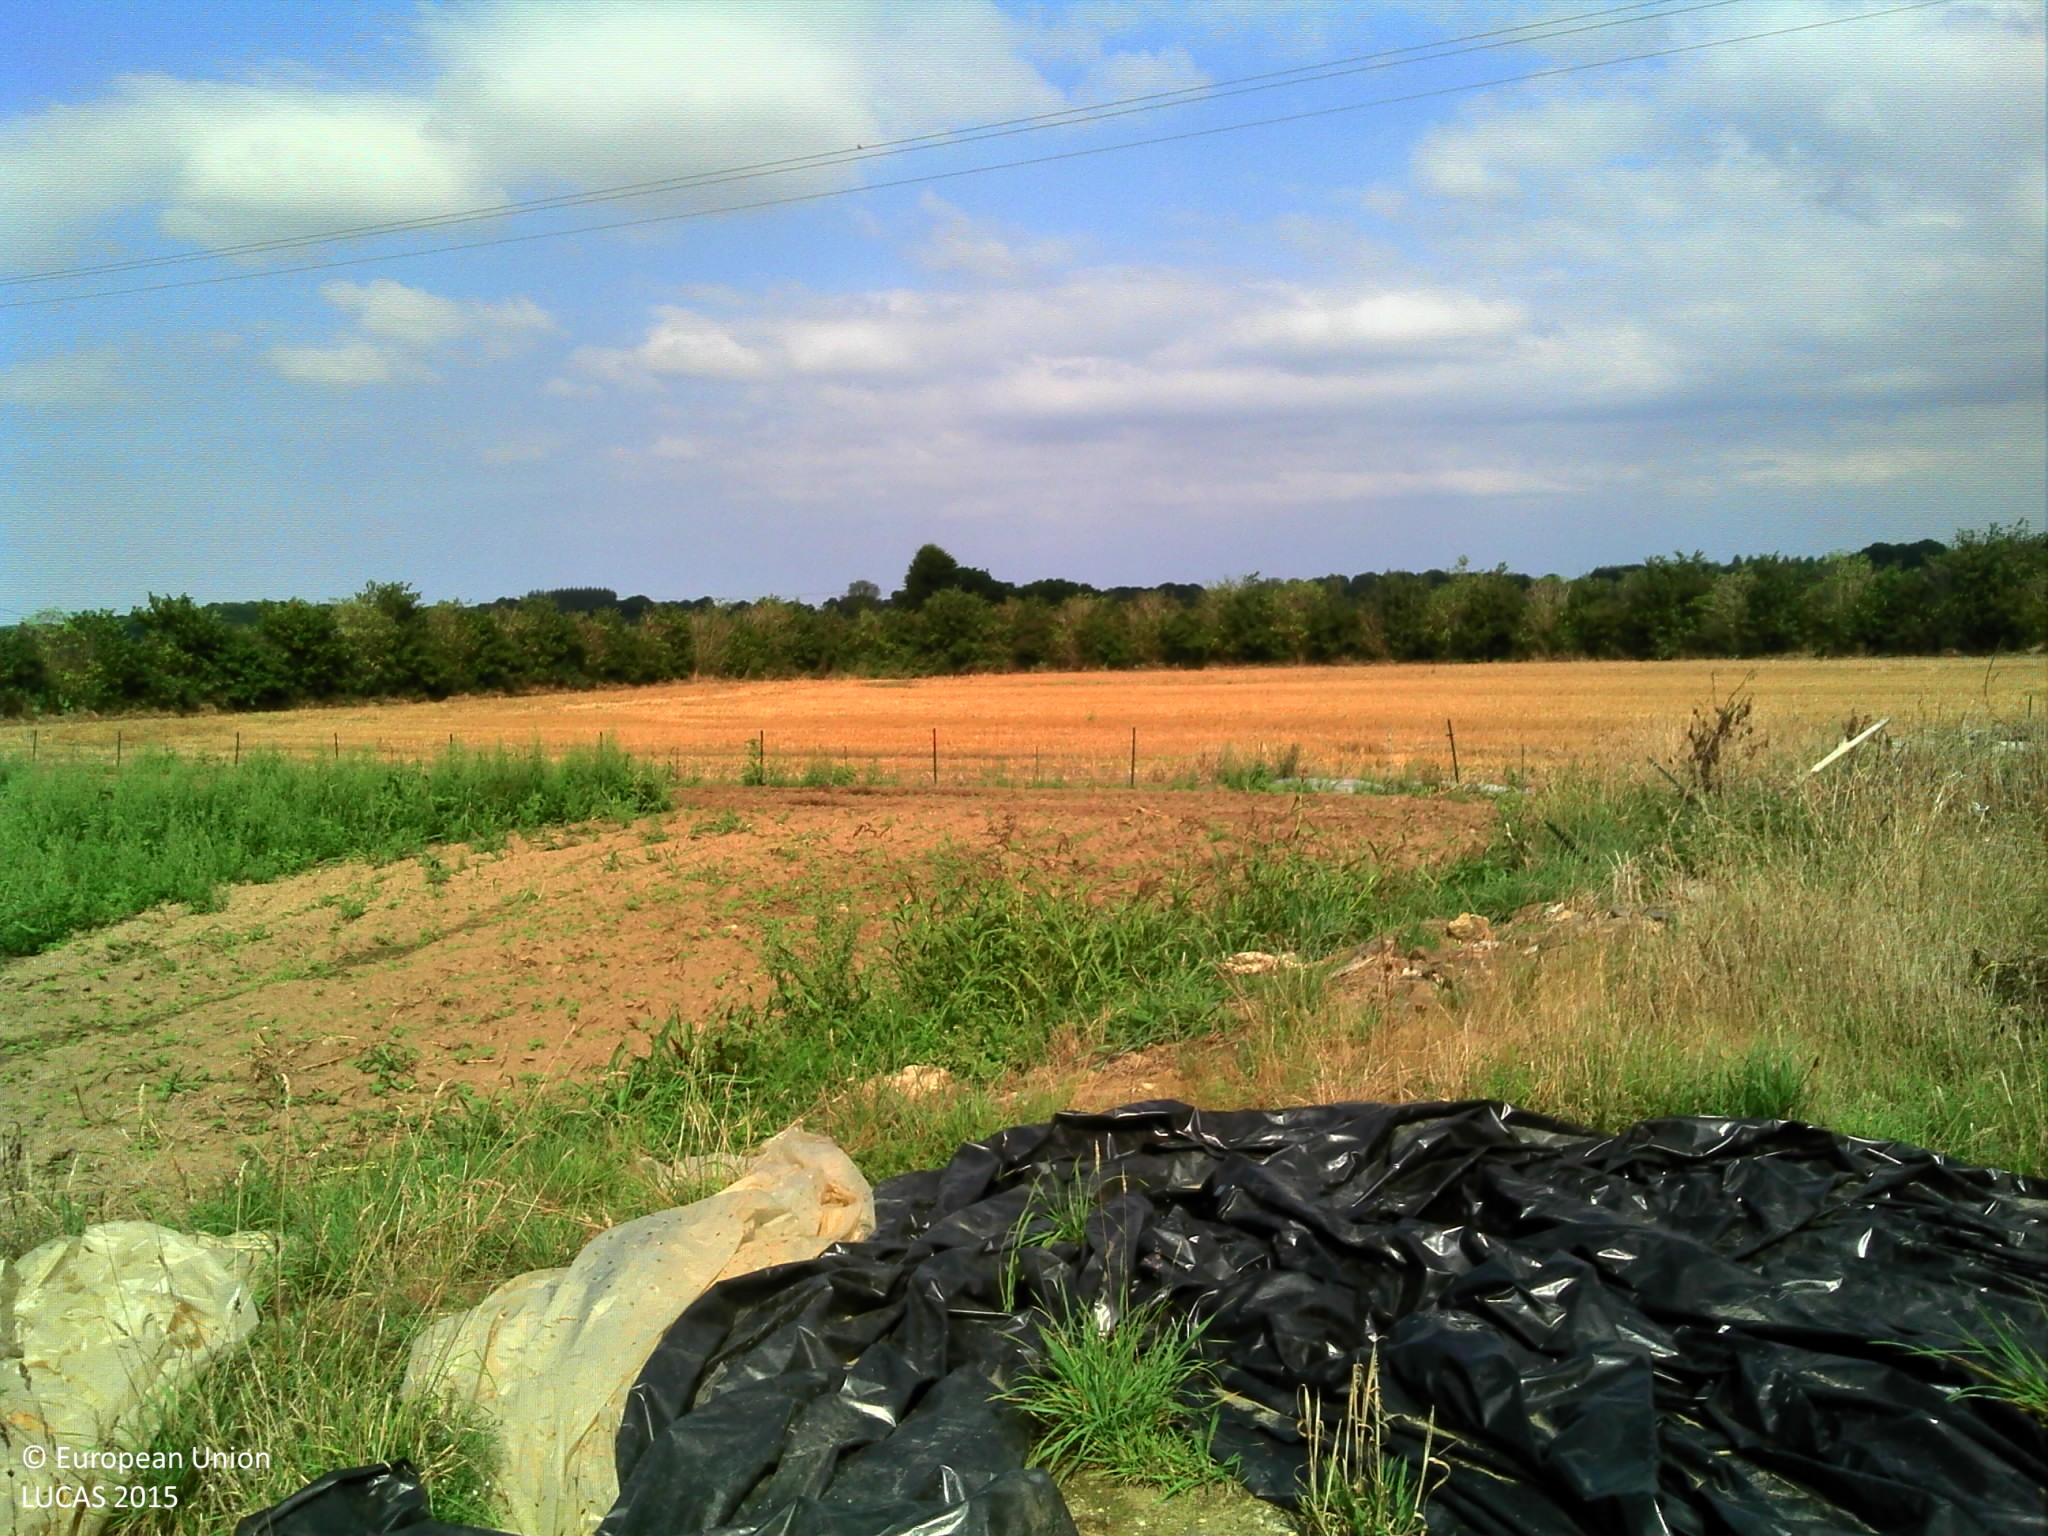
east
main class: Grassland
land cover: Spontaneously vegetated surfaces
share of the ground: 50 - 75 %
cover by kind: herbaceous plants 50 %, unconsolidated bare surface 50 %
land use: Agriculture (excluding fallow land and kitchen gardens)
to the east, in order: Spontaneously vegetated surfaces; Other bare soil; Electric lines; Other bare soil; Fences; Common wheat; Lines of trees; Temporary grasslands
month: August
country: FR
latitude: 48.6406
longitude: -3.2527
